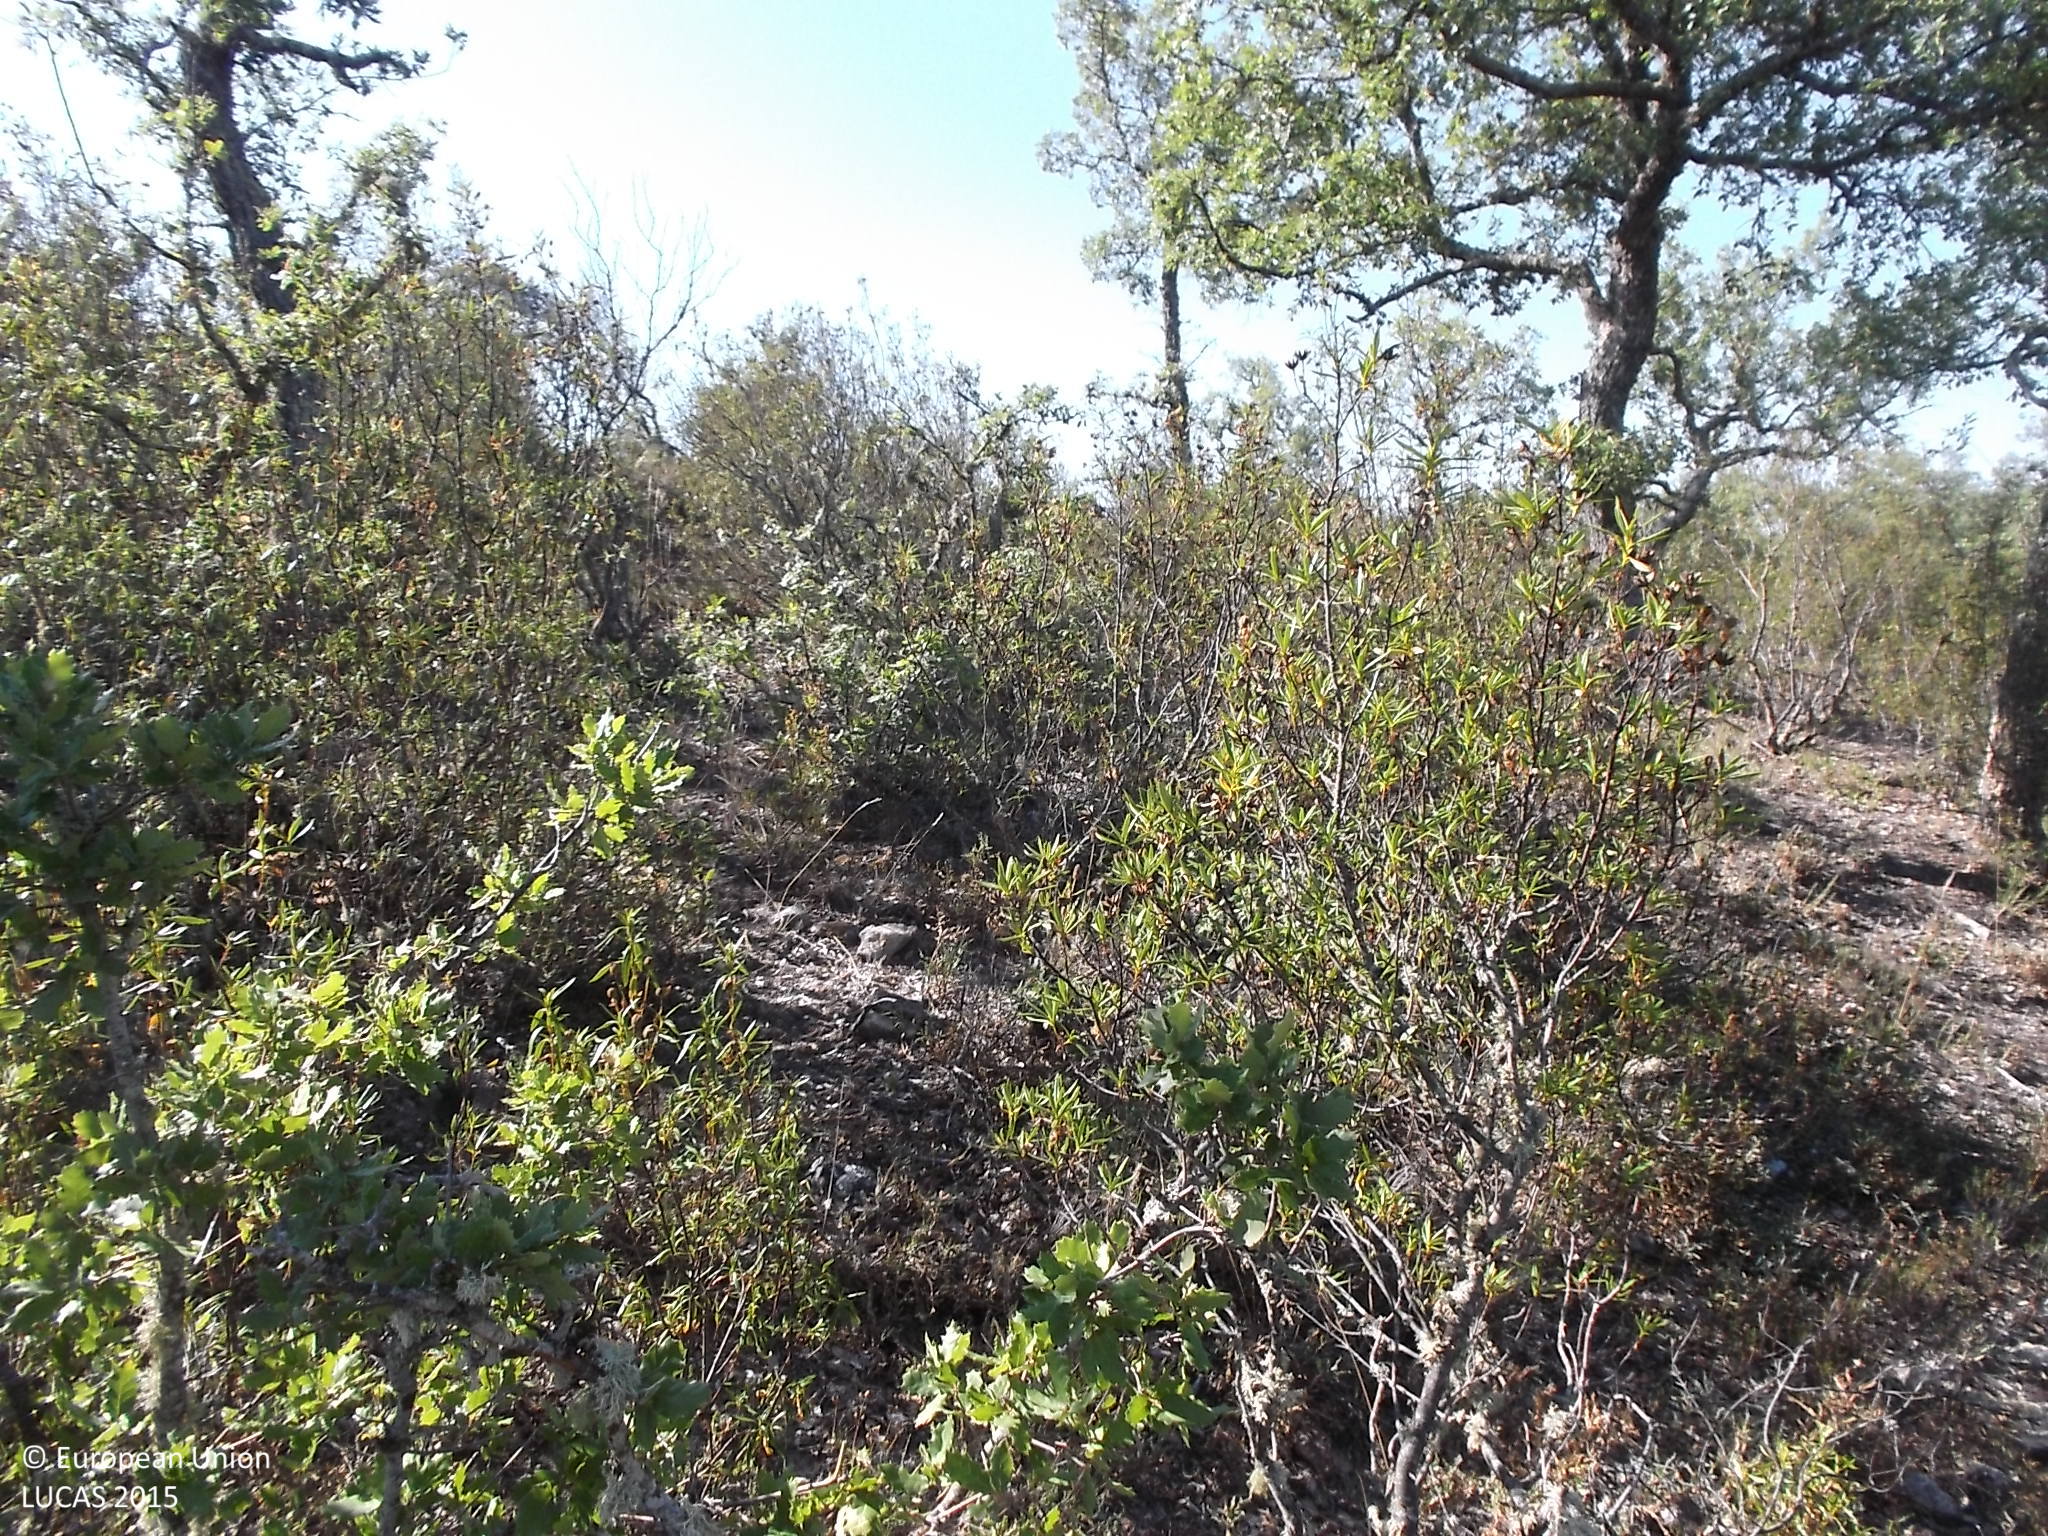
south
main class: Woodland
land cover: Broadleaved woodland
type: broadleaved evergreen forest
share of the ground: 10 - 25 %
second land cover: Shrubland without tree cover
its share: 50 - 75 %
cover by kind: shrubs 80 %, broadleaved forest trees 20 %
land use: Forestry
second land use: Agriculture (excluding fallow land and kitchen gardens)
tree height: < 5 m
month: July
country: ES
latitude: 41.2889
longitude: -5.8352
